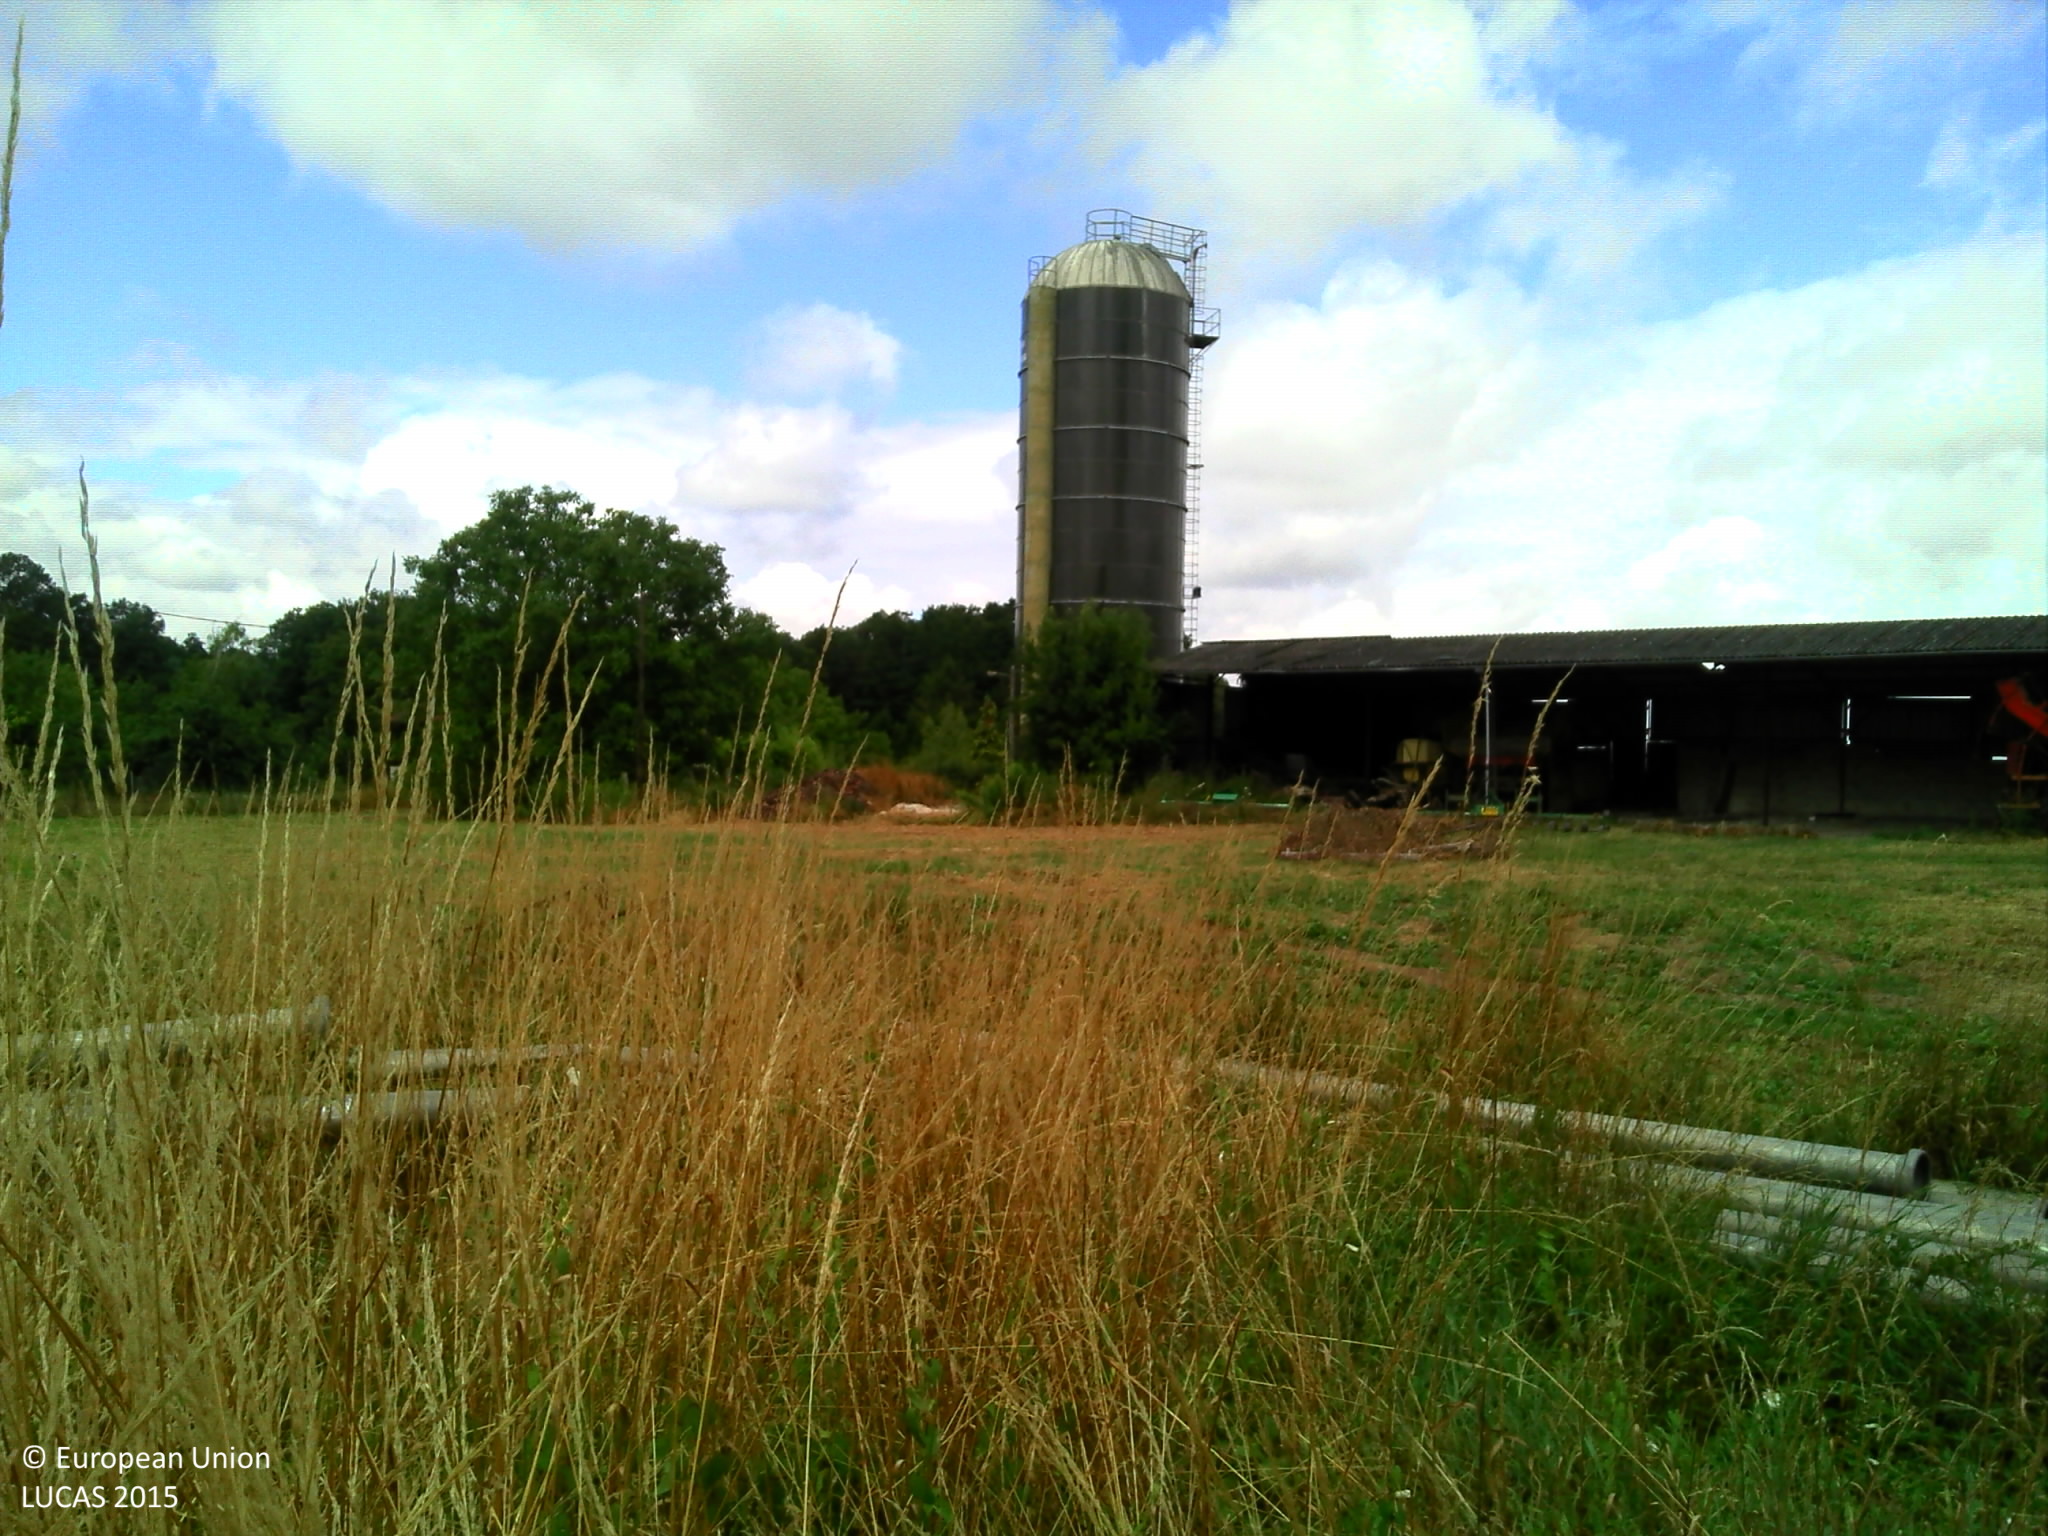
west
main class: Woodland
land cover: Broadleaved woodland
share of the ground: > 75 %
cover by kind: herbaceous plants 45 %, broadleaved forest trees 40 %, lichens and mosses 5 %, unconsolidated bare surface 5 %
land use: Semi-natural and natural areas not in use
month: July
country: FR
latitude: 49.1335
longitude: 4.5281
